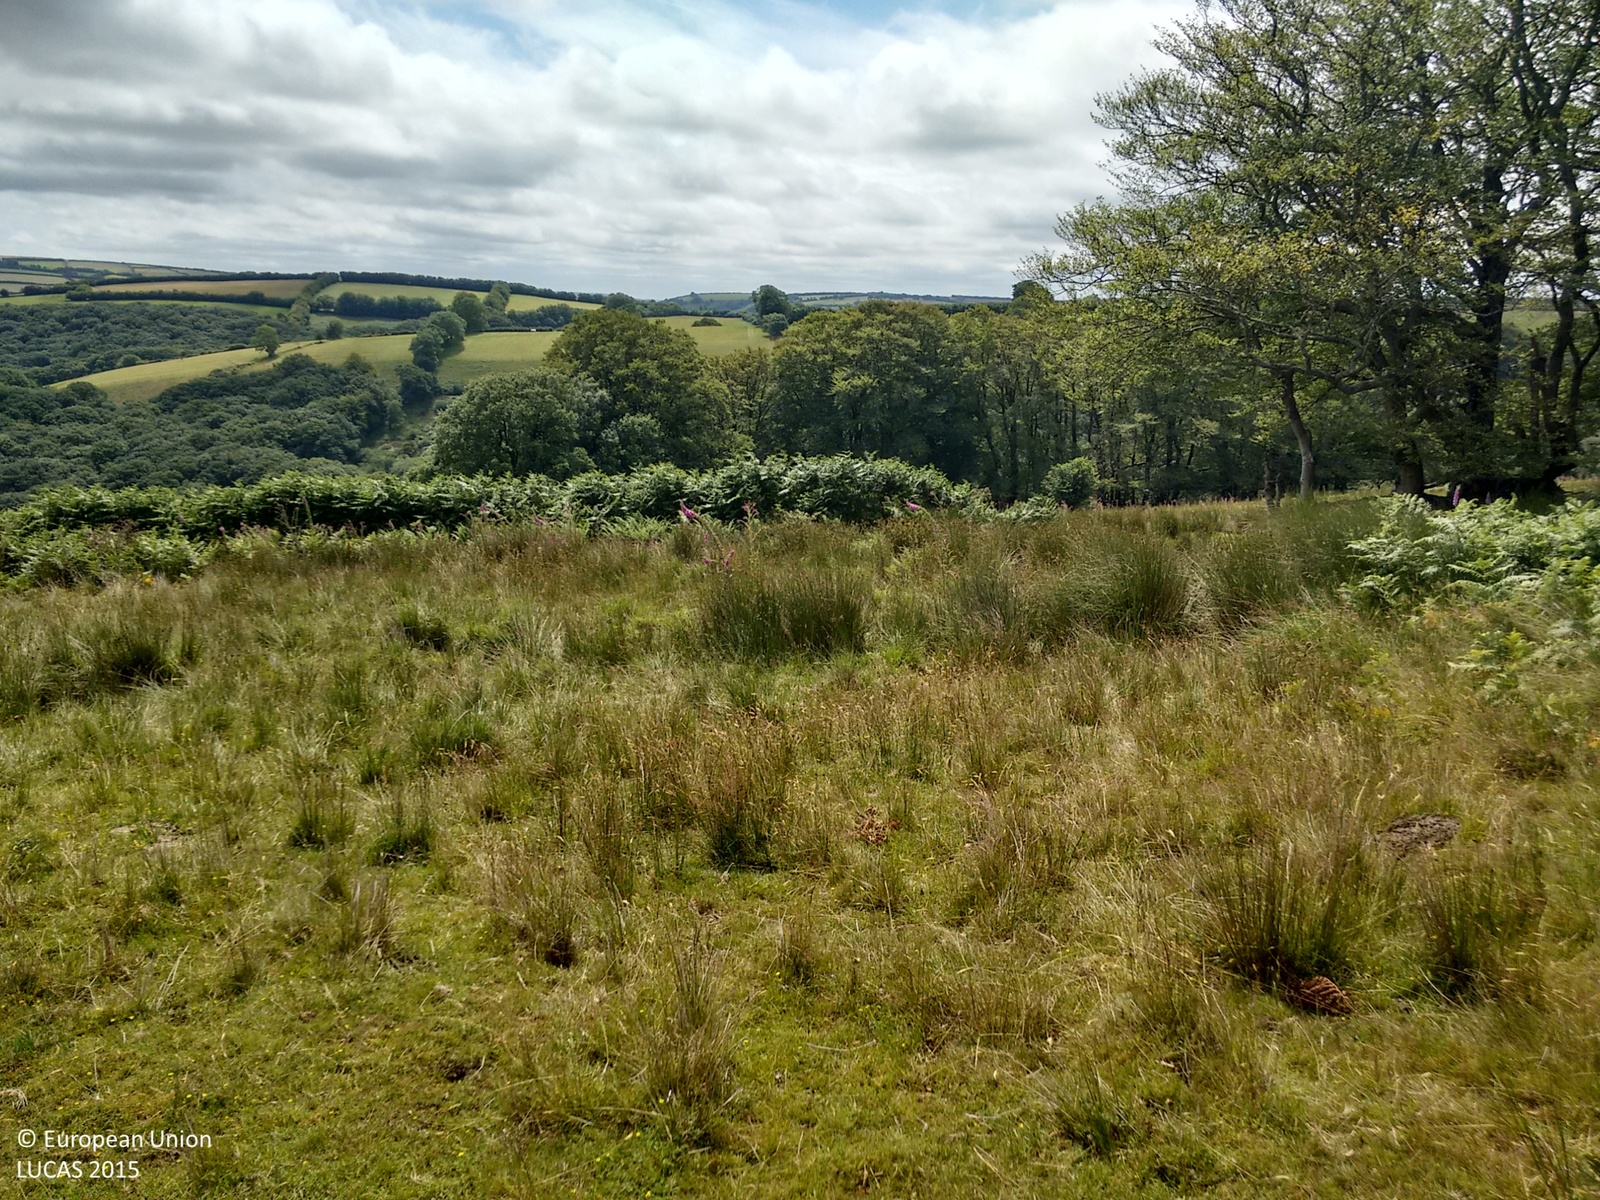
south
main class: Grassland
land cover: Grassland without tree/shrub cover
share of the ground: > 75 %
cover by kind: herbaceous plants 100 %
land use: Agriculture (excluding fallow land and kitchen gardens)
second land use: Amenities, museums, leisure
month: July
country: GB
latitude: 51.1558
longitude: -3.5684
